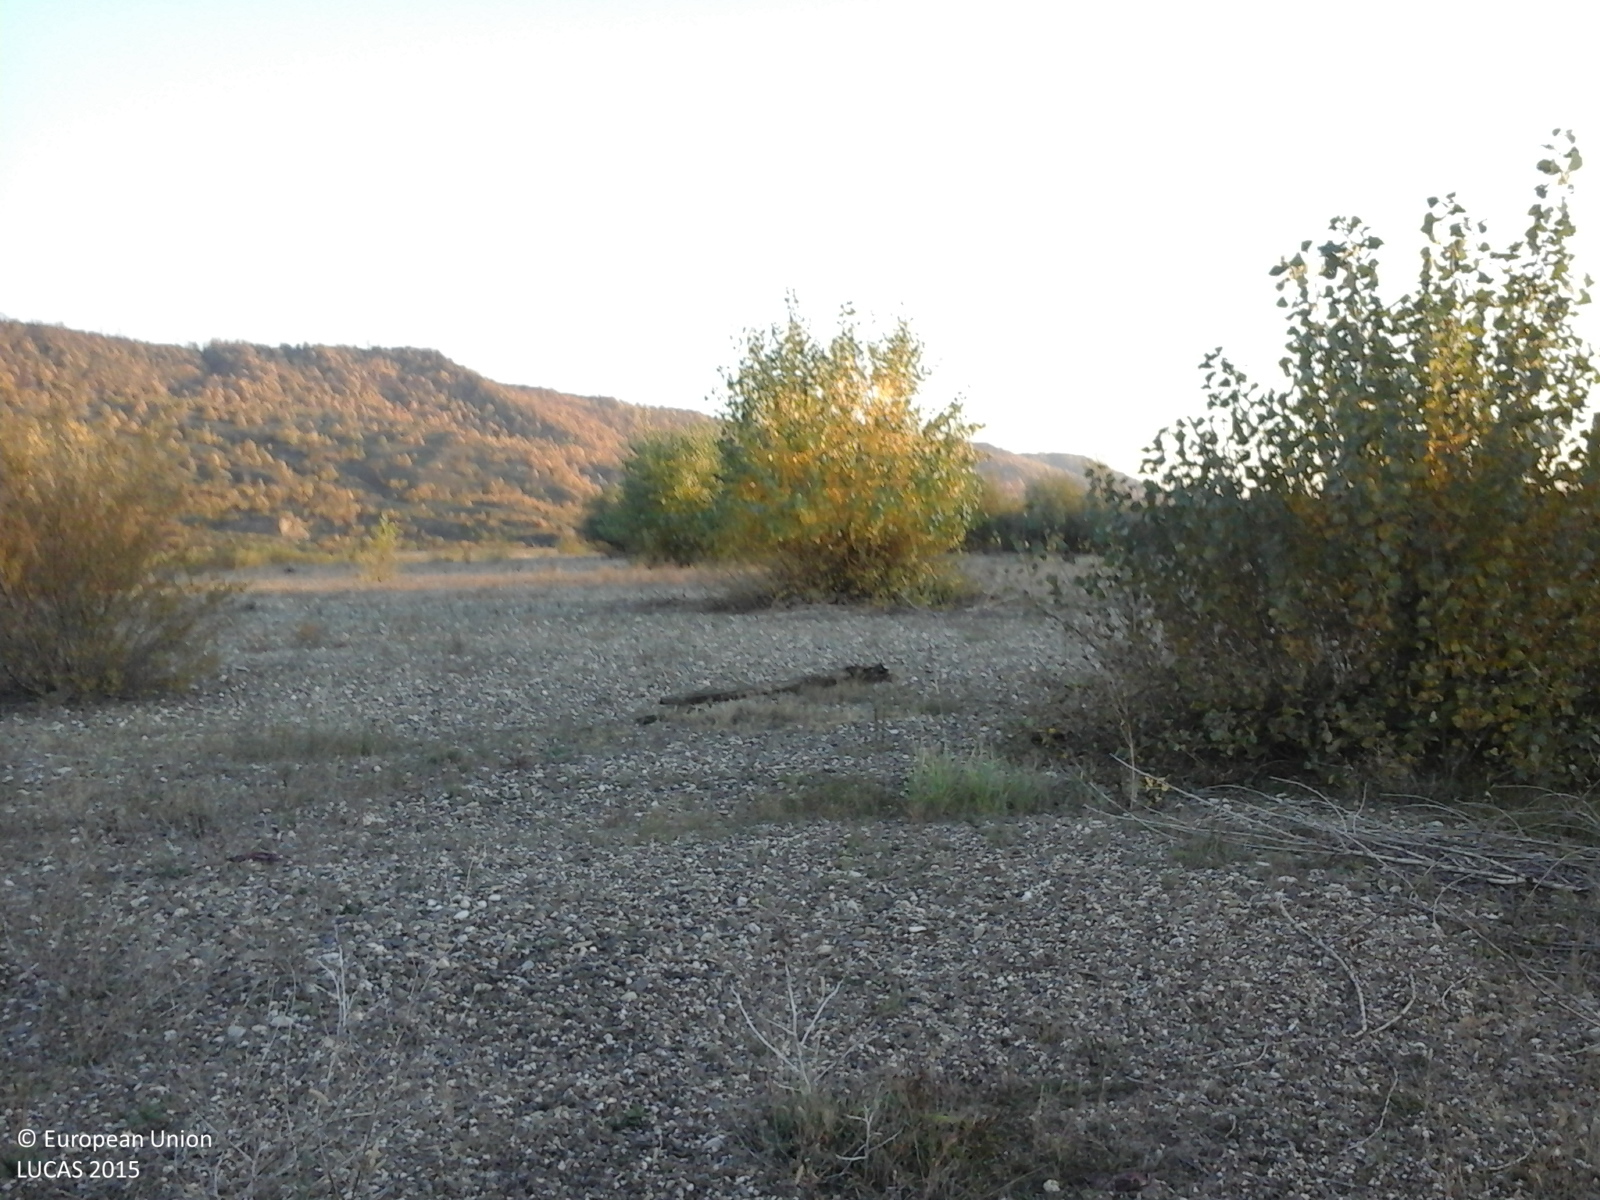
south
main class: Grassland
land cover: Spontaneously vegetated surfaces
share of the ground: 25 - 50 %
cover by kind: consolidated bare surface 75 %, herbaceous plants 25 %
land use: Semi-natural and natural areas not in use
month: October
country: RO
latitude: 46.0407
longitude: 27.2468
